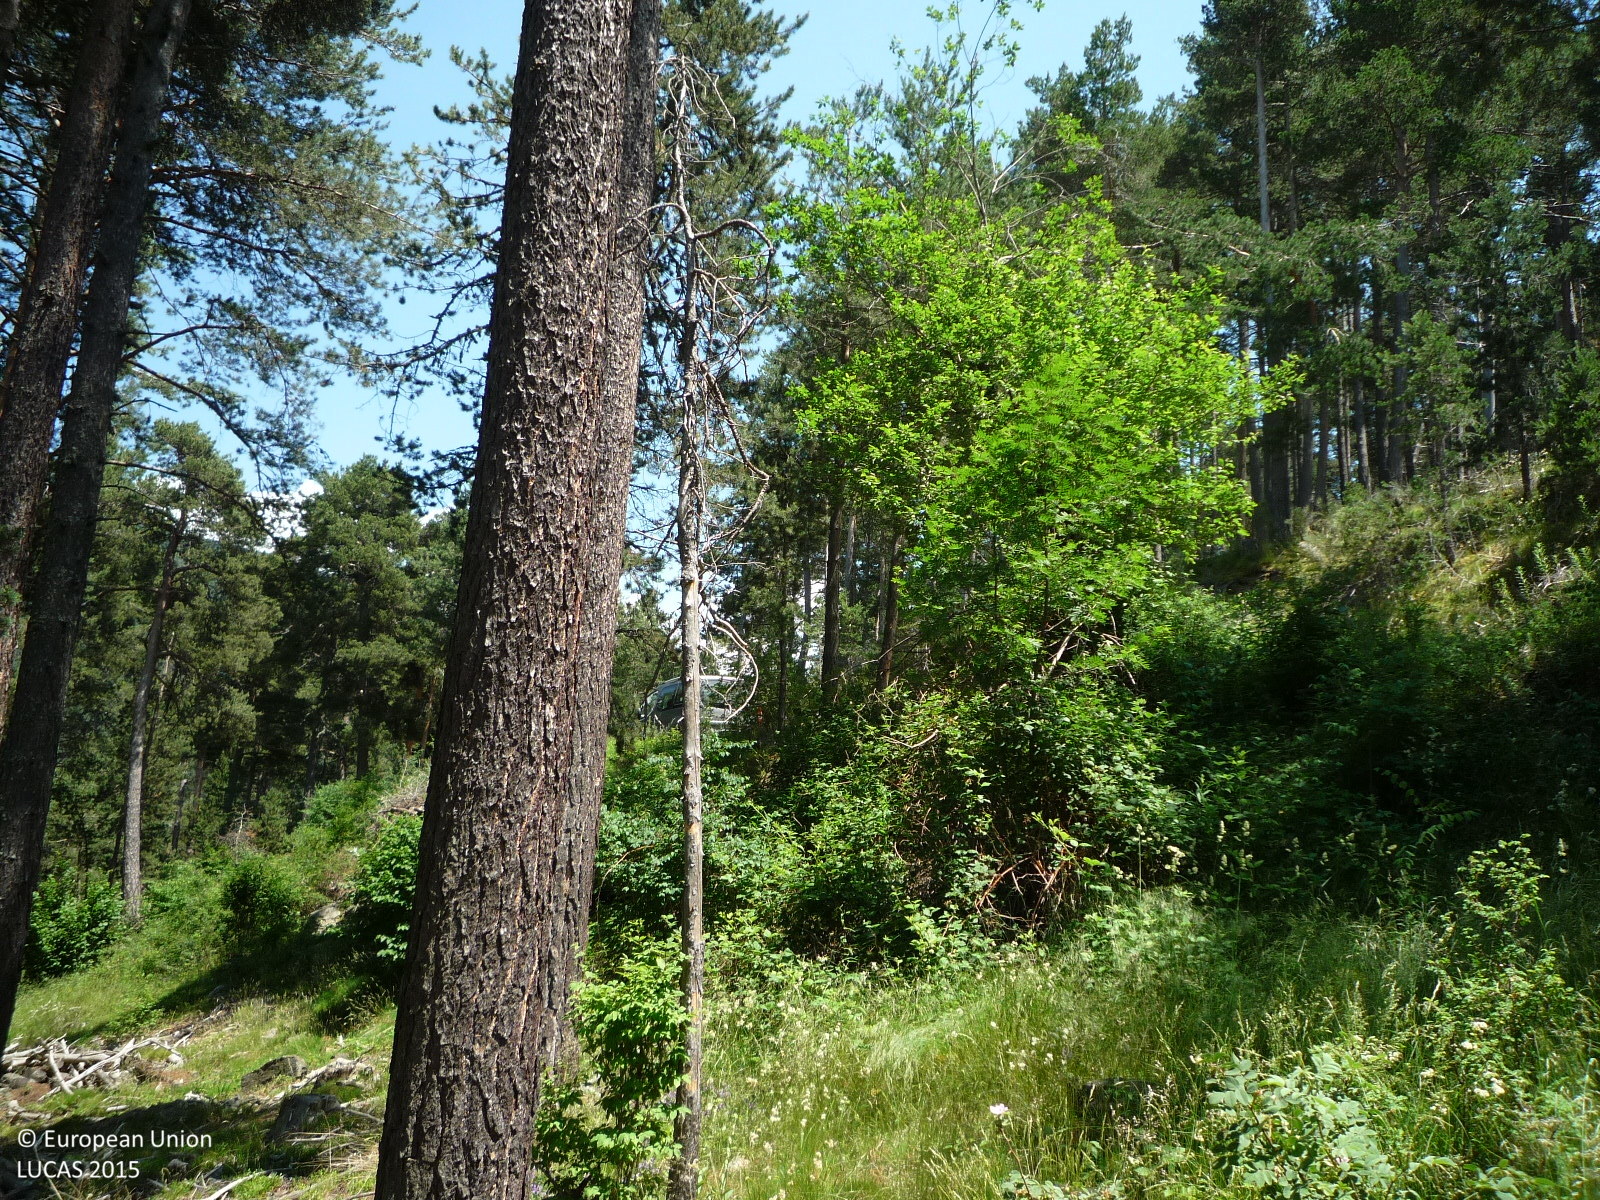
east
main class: Woodland
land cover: Pine dominated coniferous woodland
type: alpine coniferous forest
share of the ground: > 75 %
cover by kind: coniferous forest trees 90 %, herbaceous plants 10 %
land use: Forestry
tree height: > 5 m
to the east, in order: Pine dominated coniferous woodland; Tracks; Pine dominated coniferous woodland; Tracks; Pine dominated coniferous woodland; Spruce dominated coniferous woodland
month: June
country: ES
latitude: 42.3524
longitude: 1.9629
